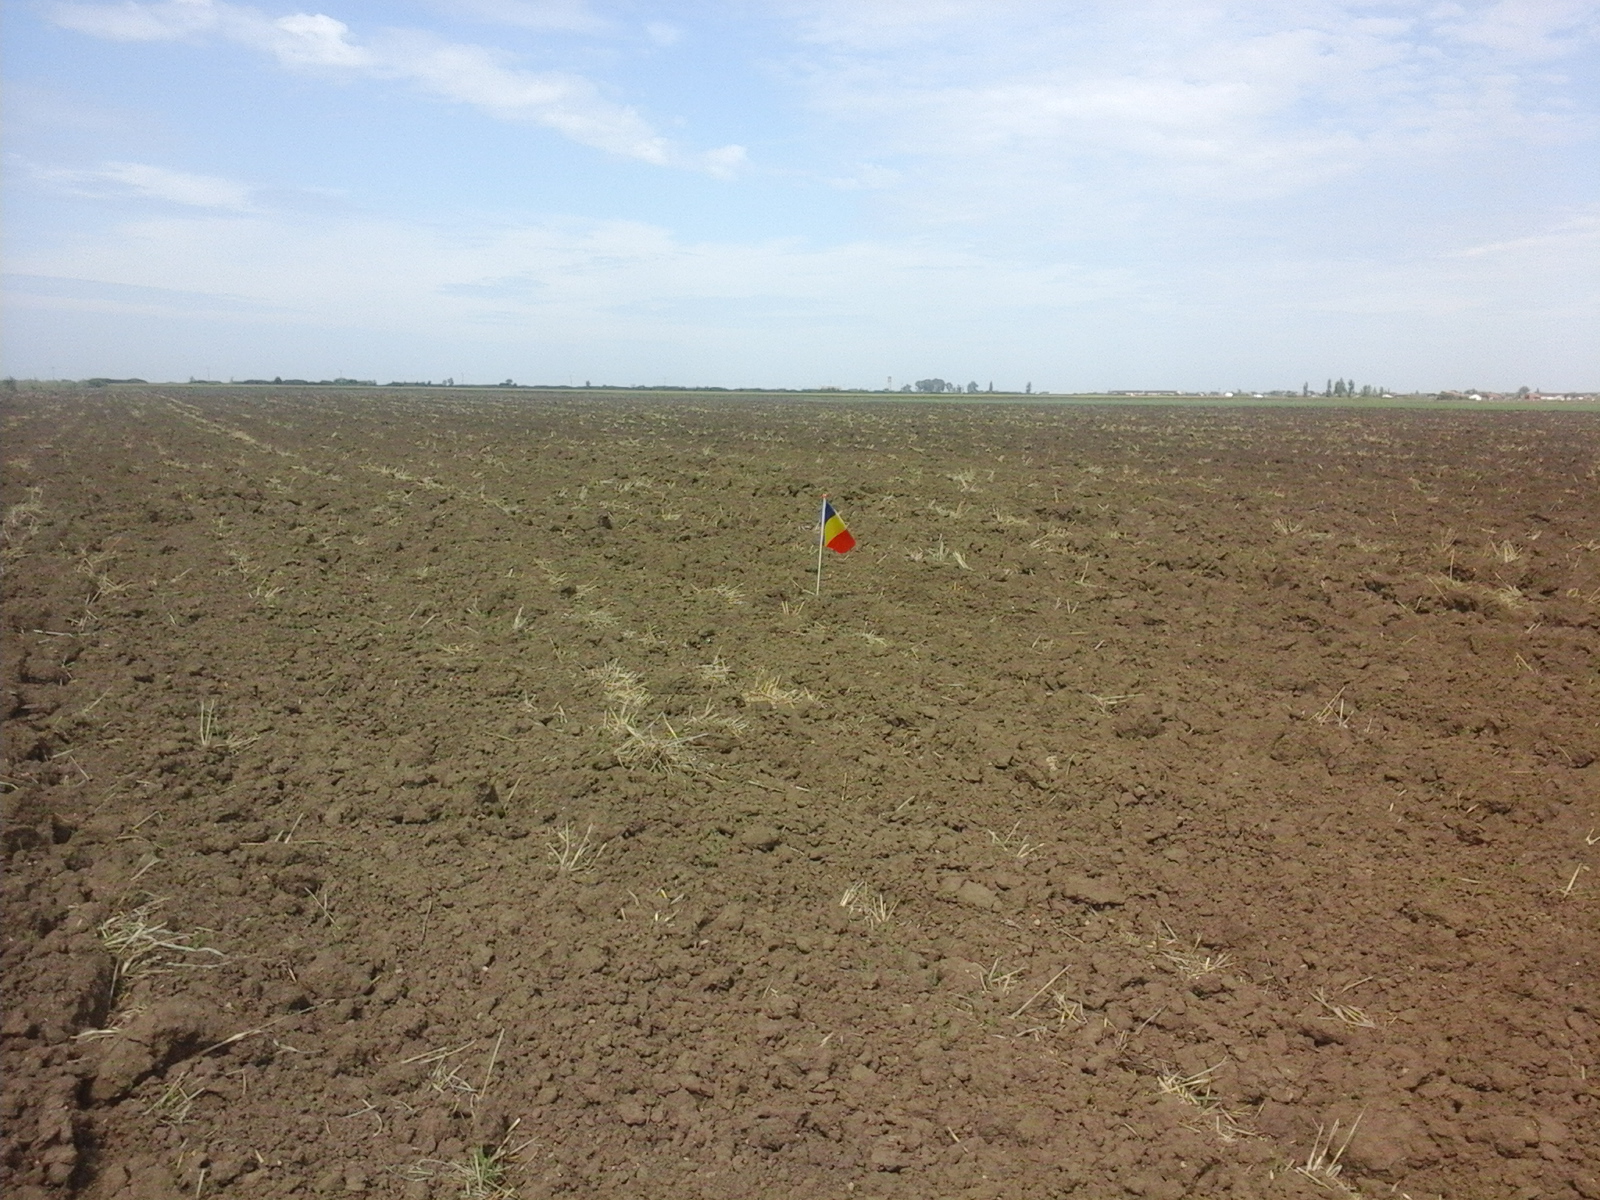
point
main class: Cropland
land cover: Common wheat
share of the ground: < 10 %
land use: Agriculture (excluding fallow land and kitchen gardens)
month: August
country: RO
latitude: 46.4813
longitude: 21.4345
